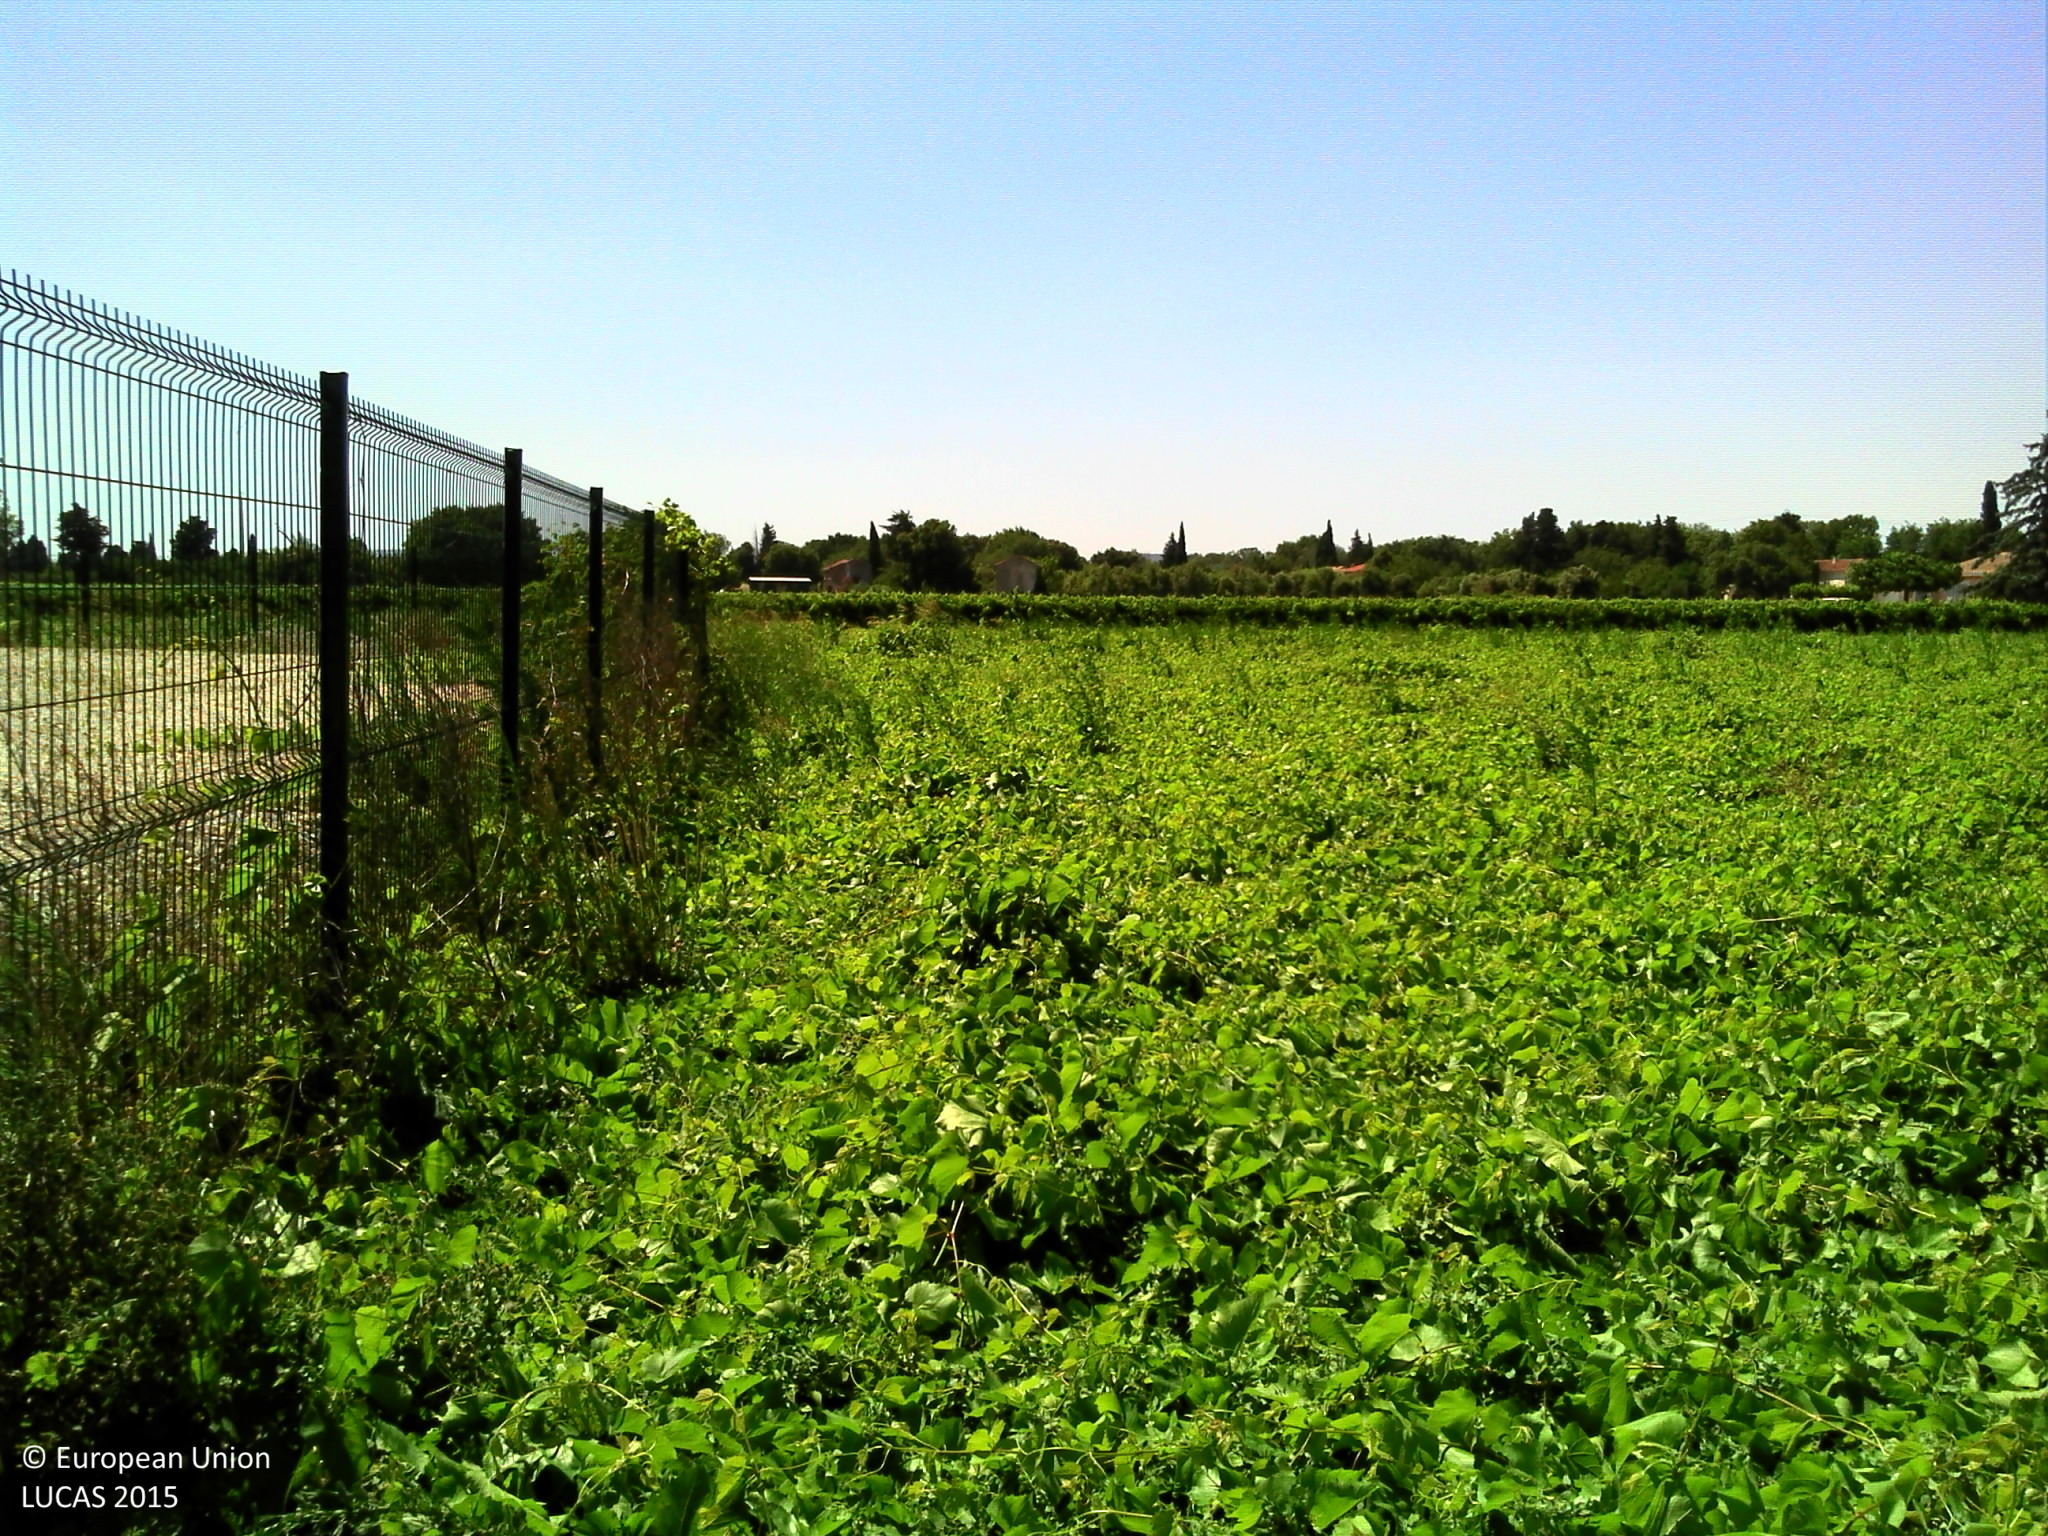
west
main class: Cropland
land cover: Nurseries
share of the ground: > 75 %
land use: Agriculture (excluding fallow land and kitchen gardens)
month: July
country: FR
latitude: 44.1476
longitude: 4.7946
